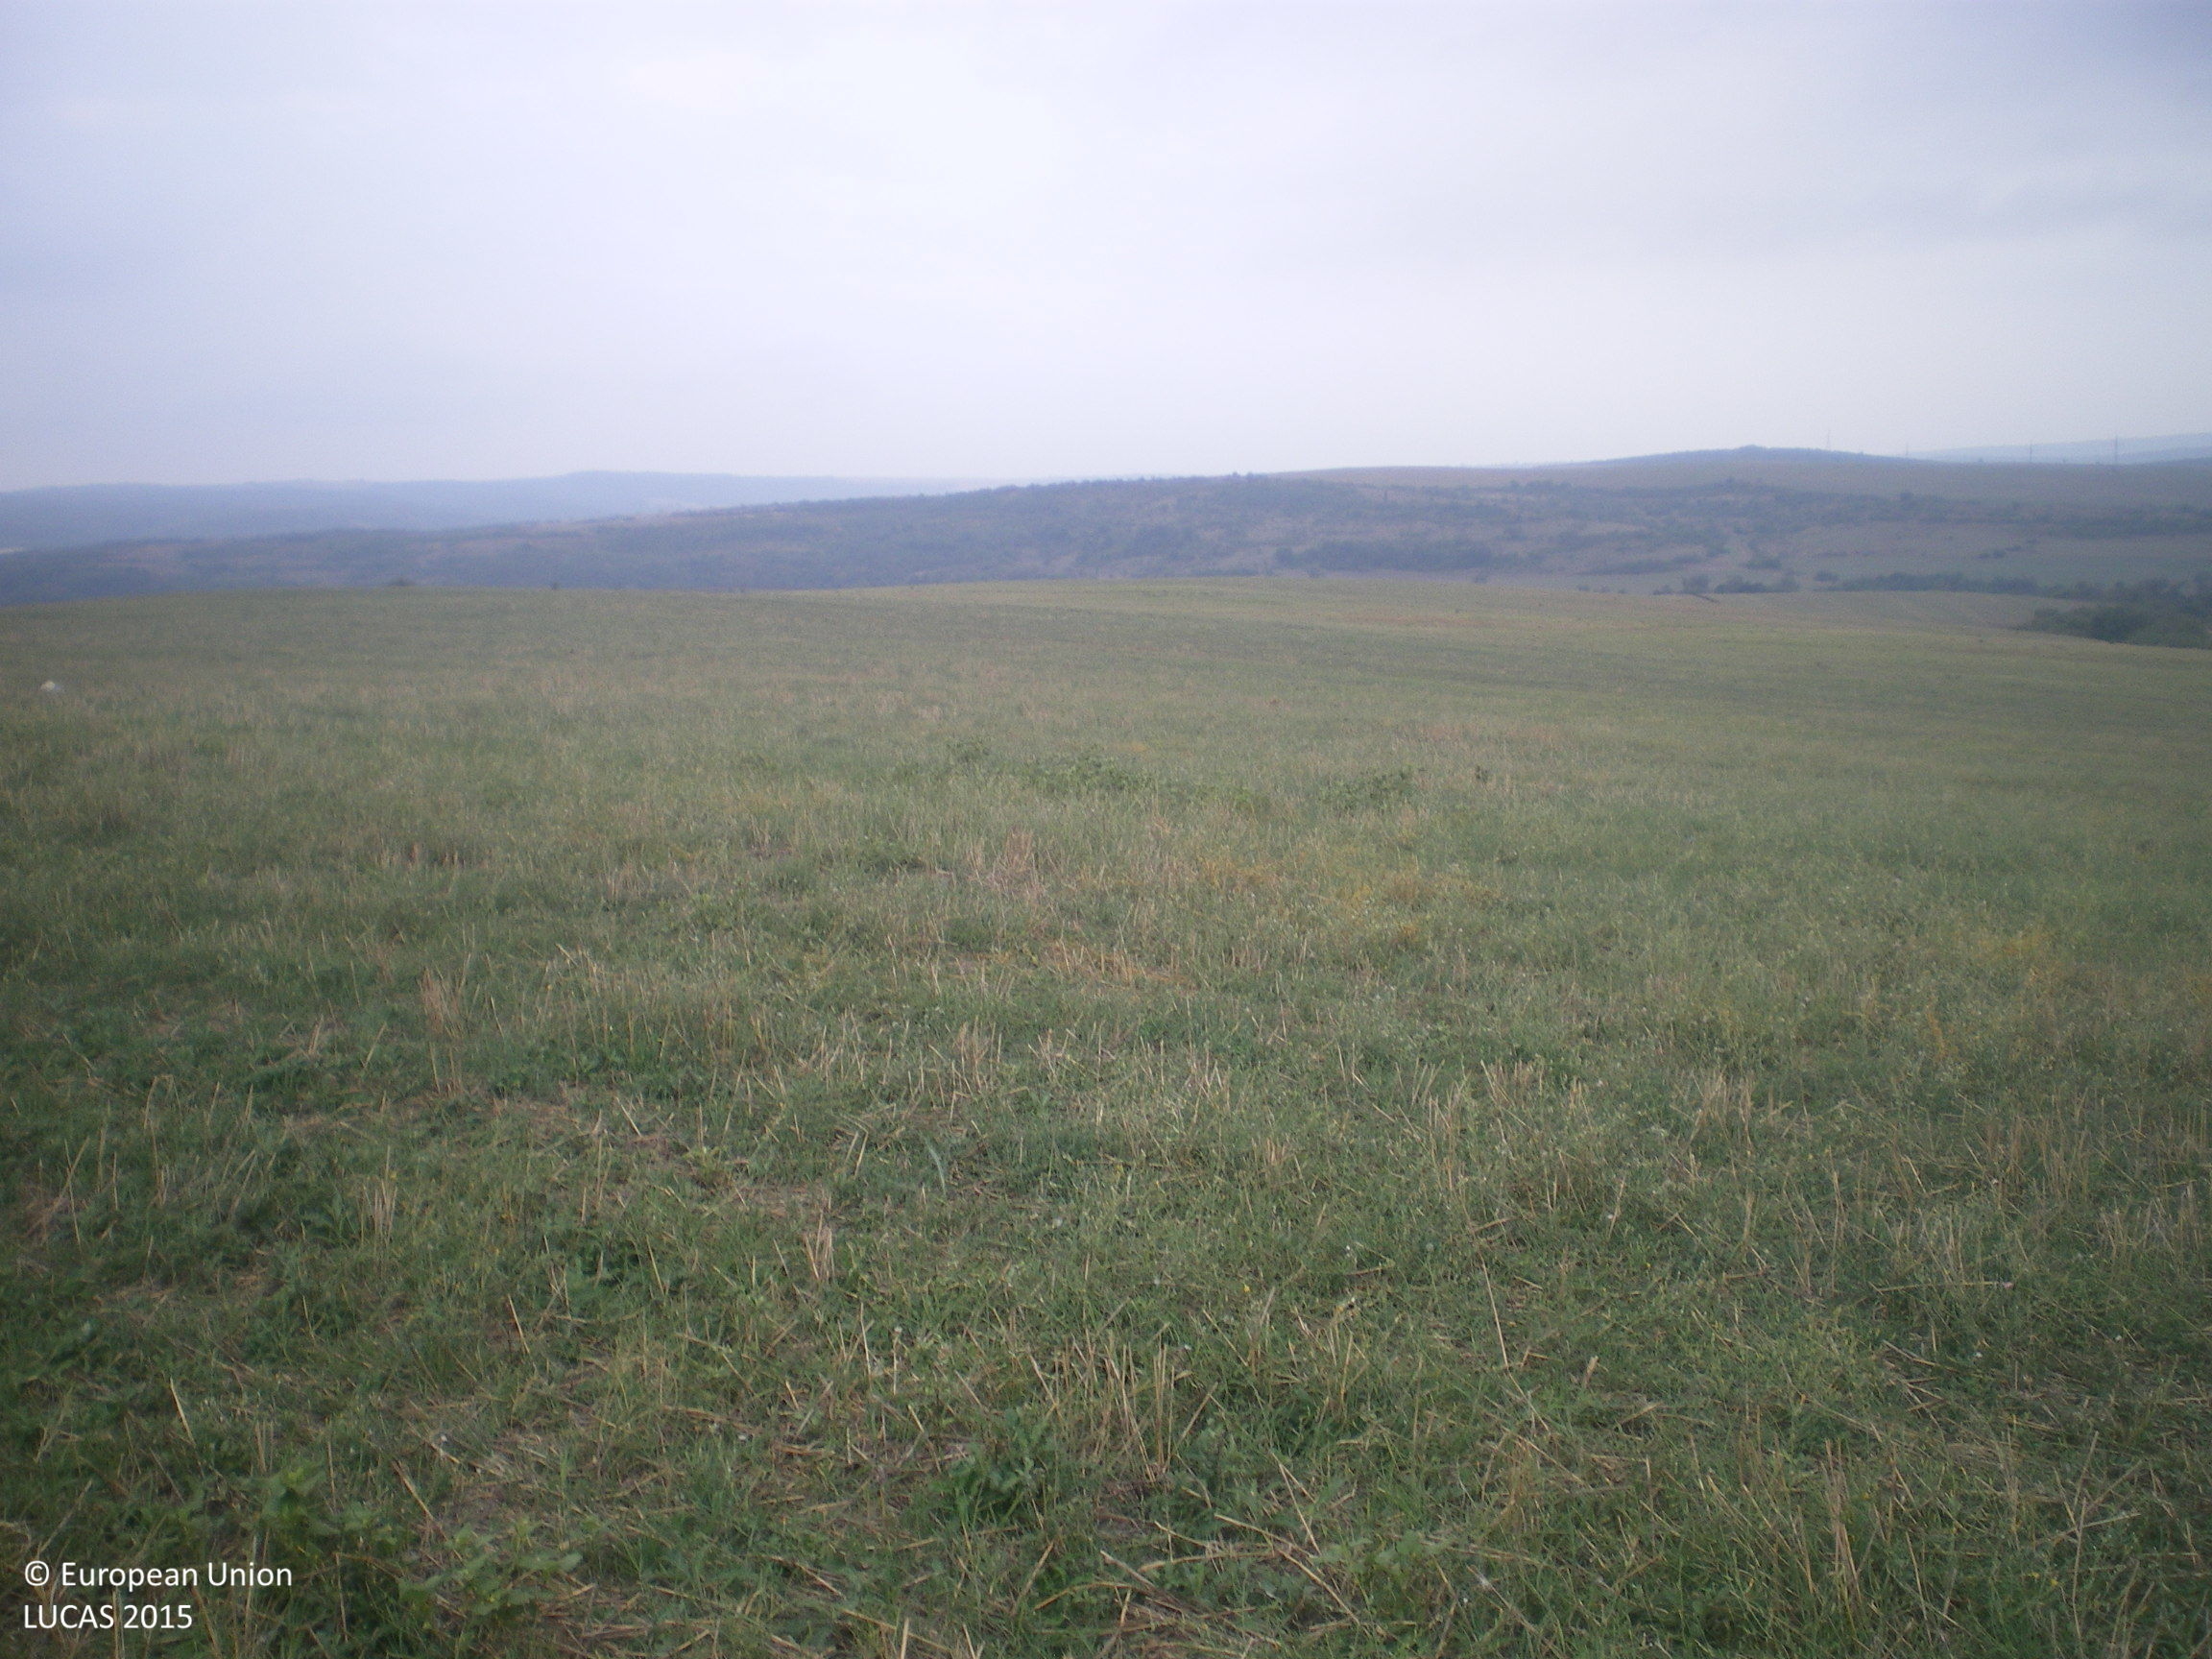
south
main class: Cropland
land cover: Barley
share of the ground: < 10 %
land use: Agriculture (excluding fallow land and kitchen gardens)
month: September
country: BG
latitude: 42.0456
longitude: 25.8131
